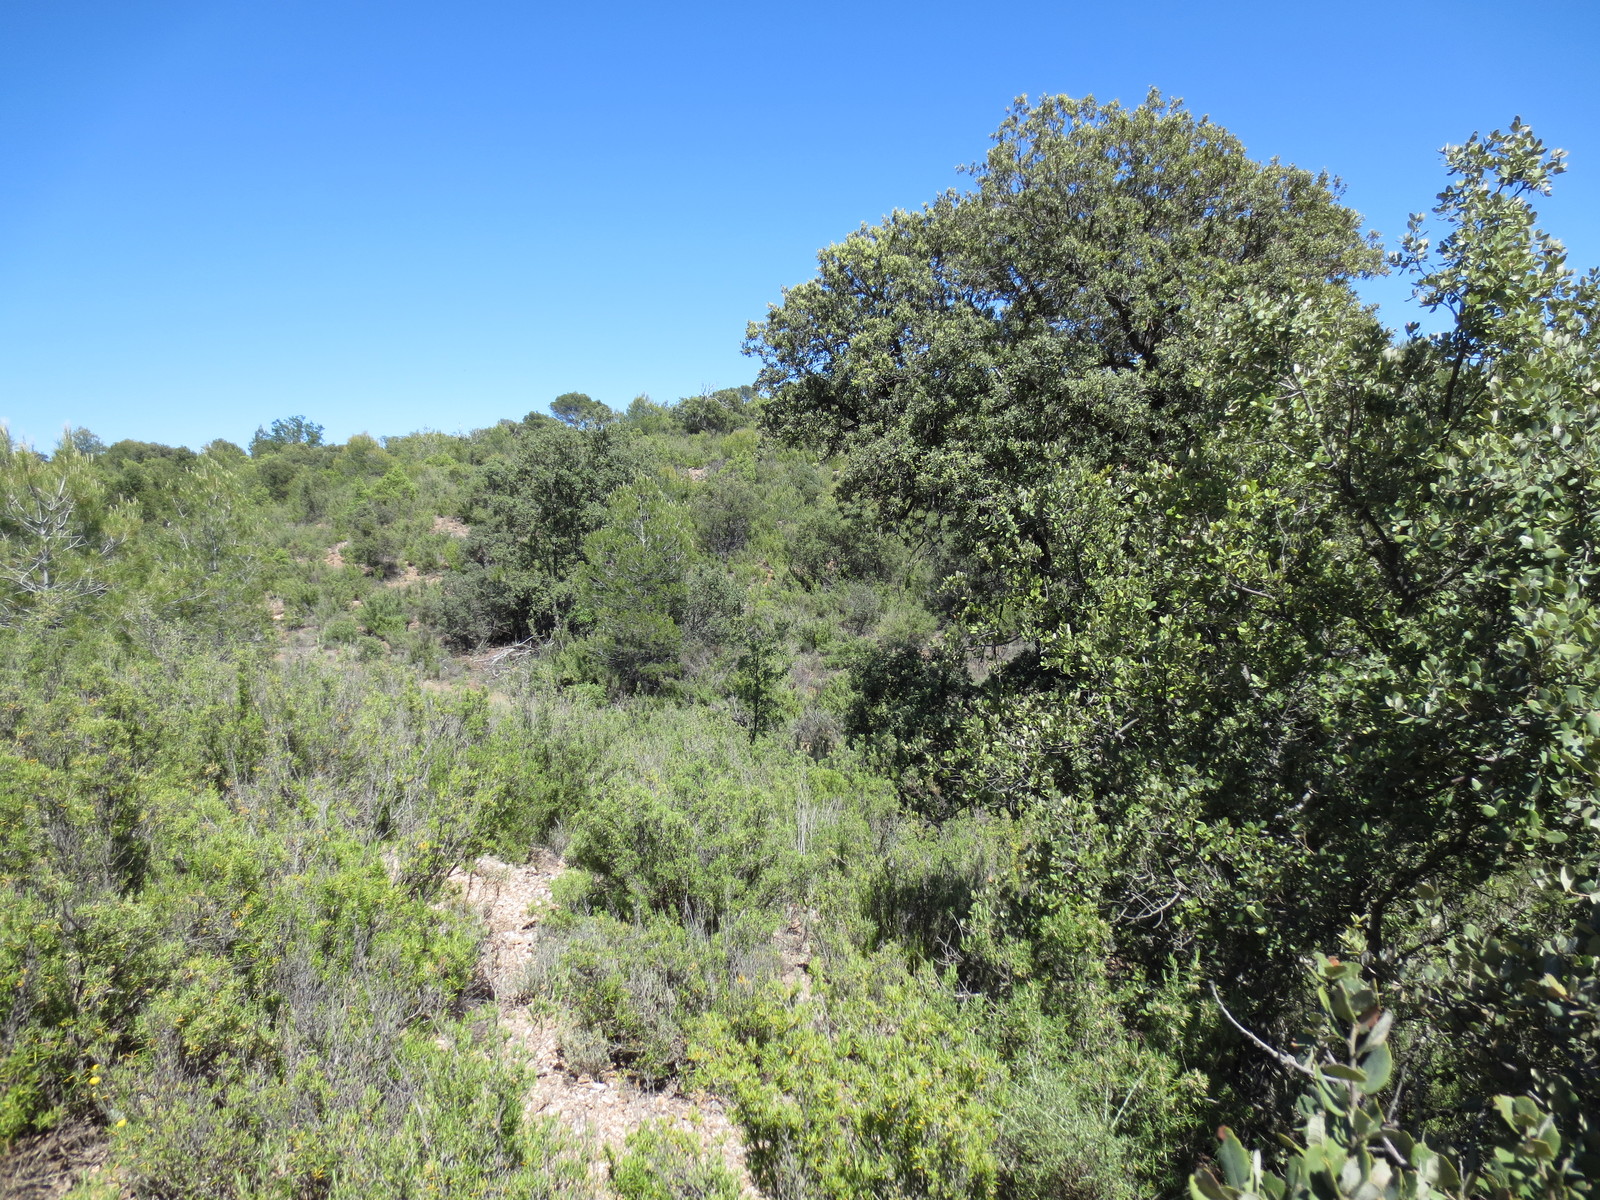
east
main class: Shrubland
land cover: Shrubland with sparse tree cover
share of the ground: > 75 %
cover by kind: shrubs 75 %, unconsolidated bare surface 20 %, coniferous forest trees 5 %
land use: Semi-natural and natural areas not in use
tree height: < 5 m
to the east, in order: Shrubland with sparse tree cover; Tracks; Shrubland with sparse tree cover; Other mixed woodland; Tracks; Shrubland with sparse tree cover
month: May
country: ES
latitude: 40.2240
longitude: -2.8458
